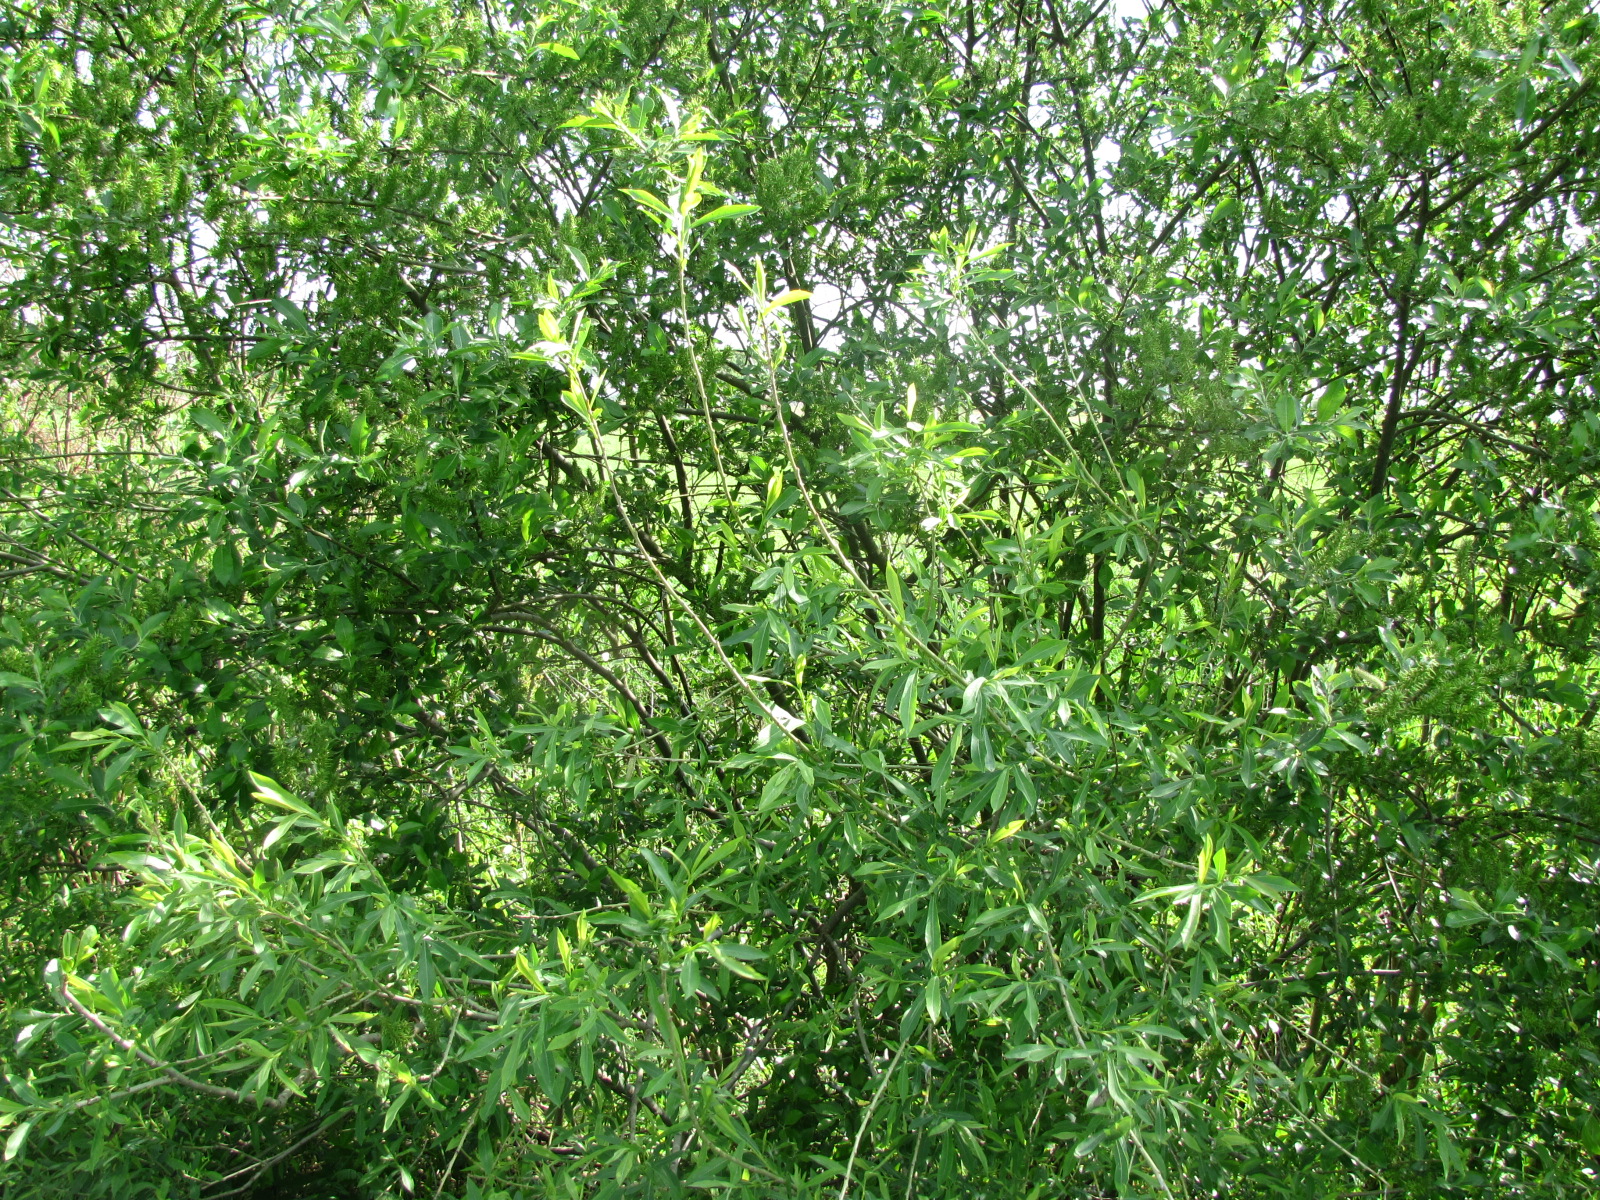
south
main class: Cropland
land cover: Common wheat
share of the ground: > 75 %
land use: Agriculture (excluding fallow land and kitchen gardens)
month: May
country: LV
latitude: 56.5774
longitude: 23.9033
